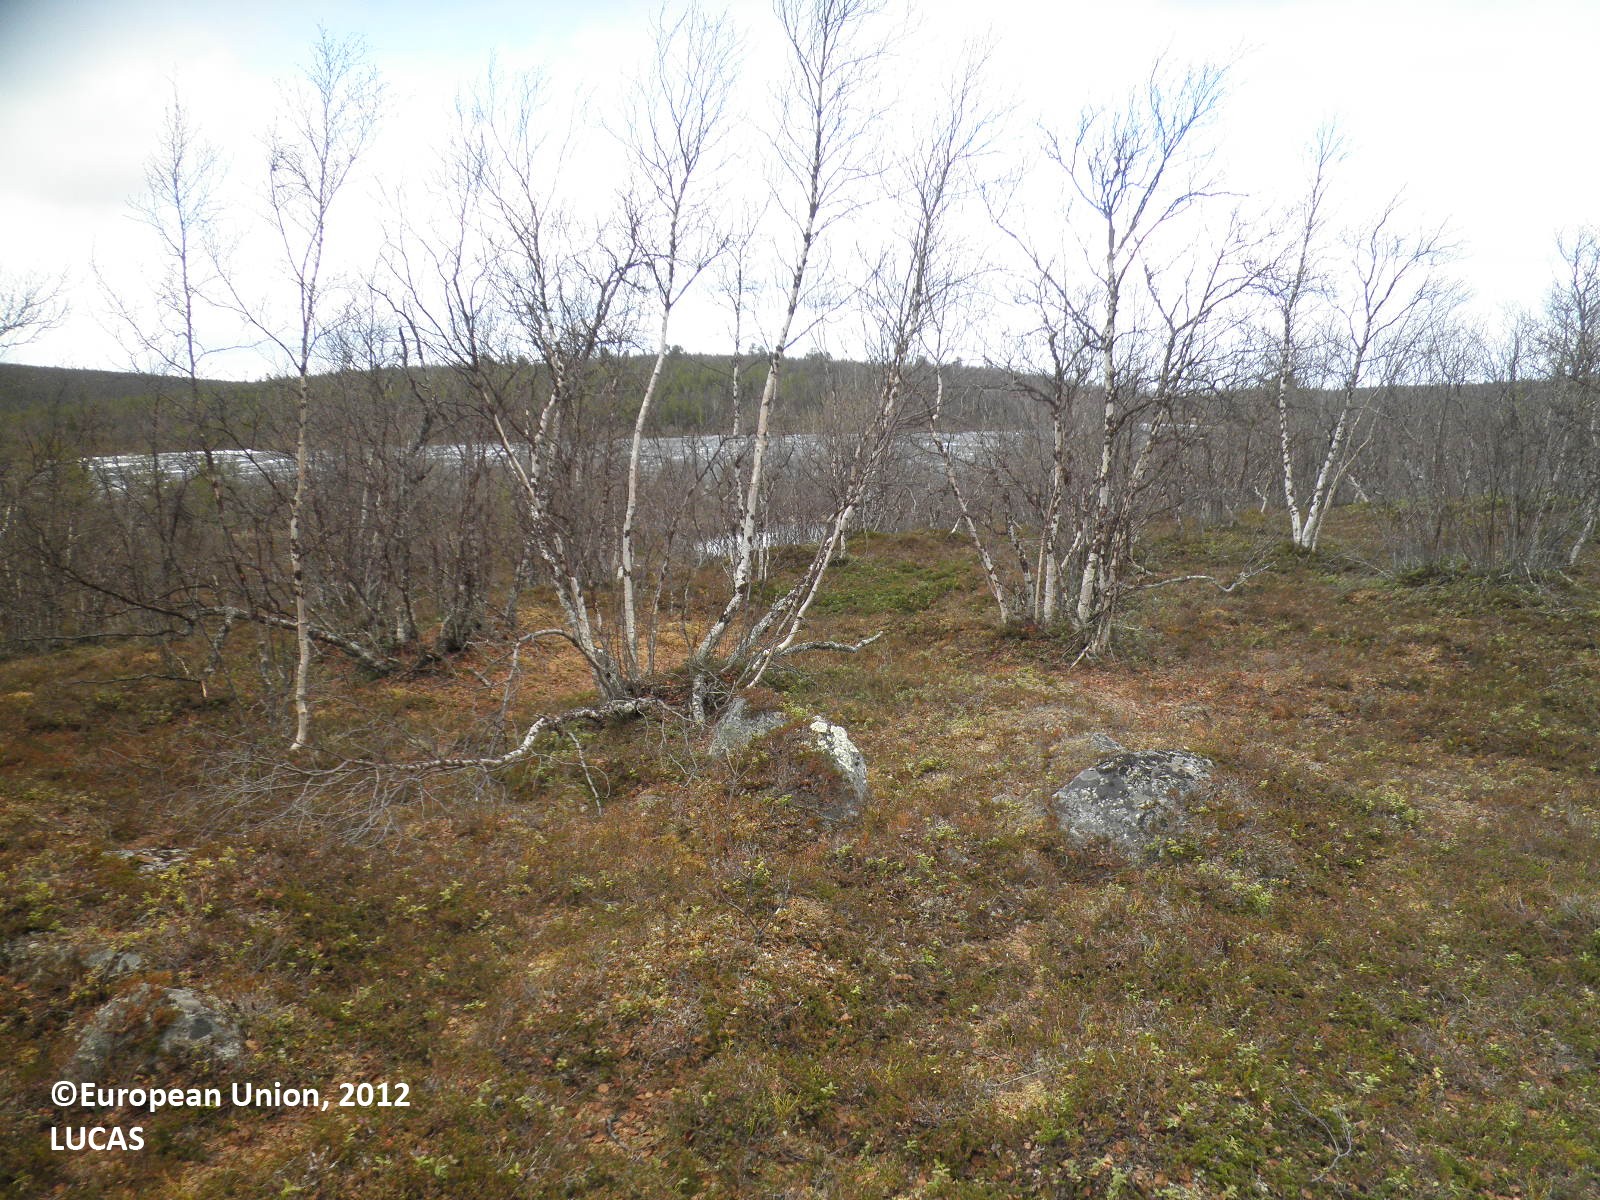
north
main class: Woodland
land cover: Broadleaved woodland
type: boreal forest
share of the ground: 50 - 75 %
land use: Forestry
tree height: > 5 m
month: May
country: FI
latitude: 69.1819
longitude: 26.9192
